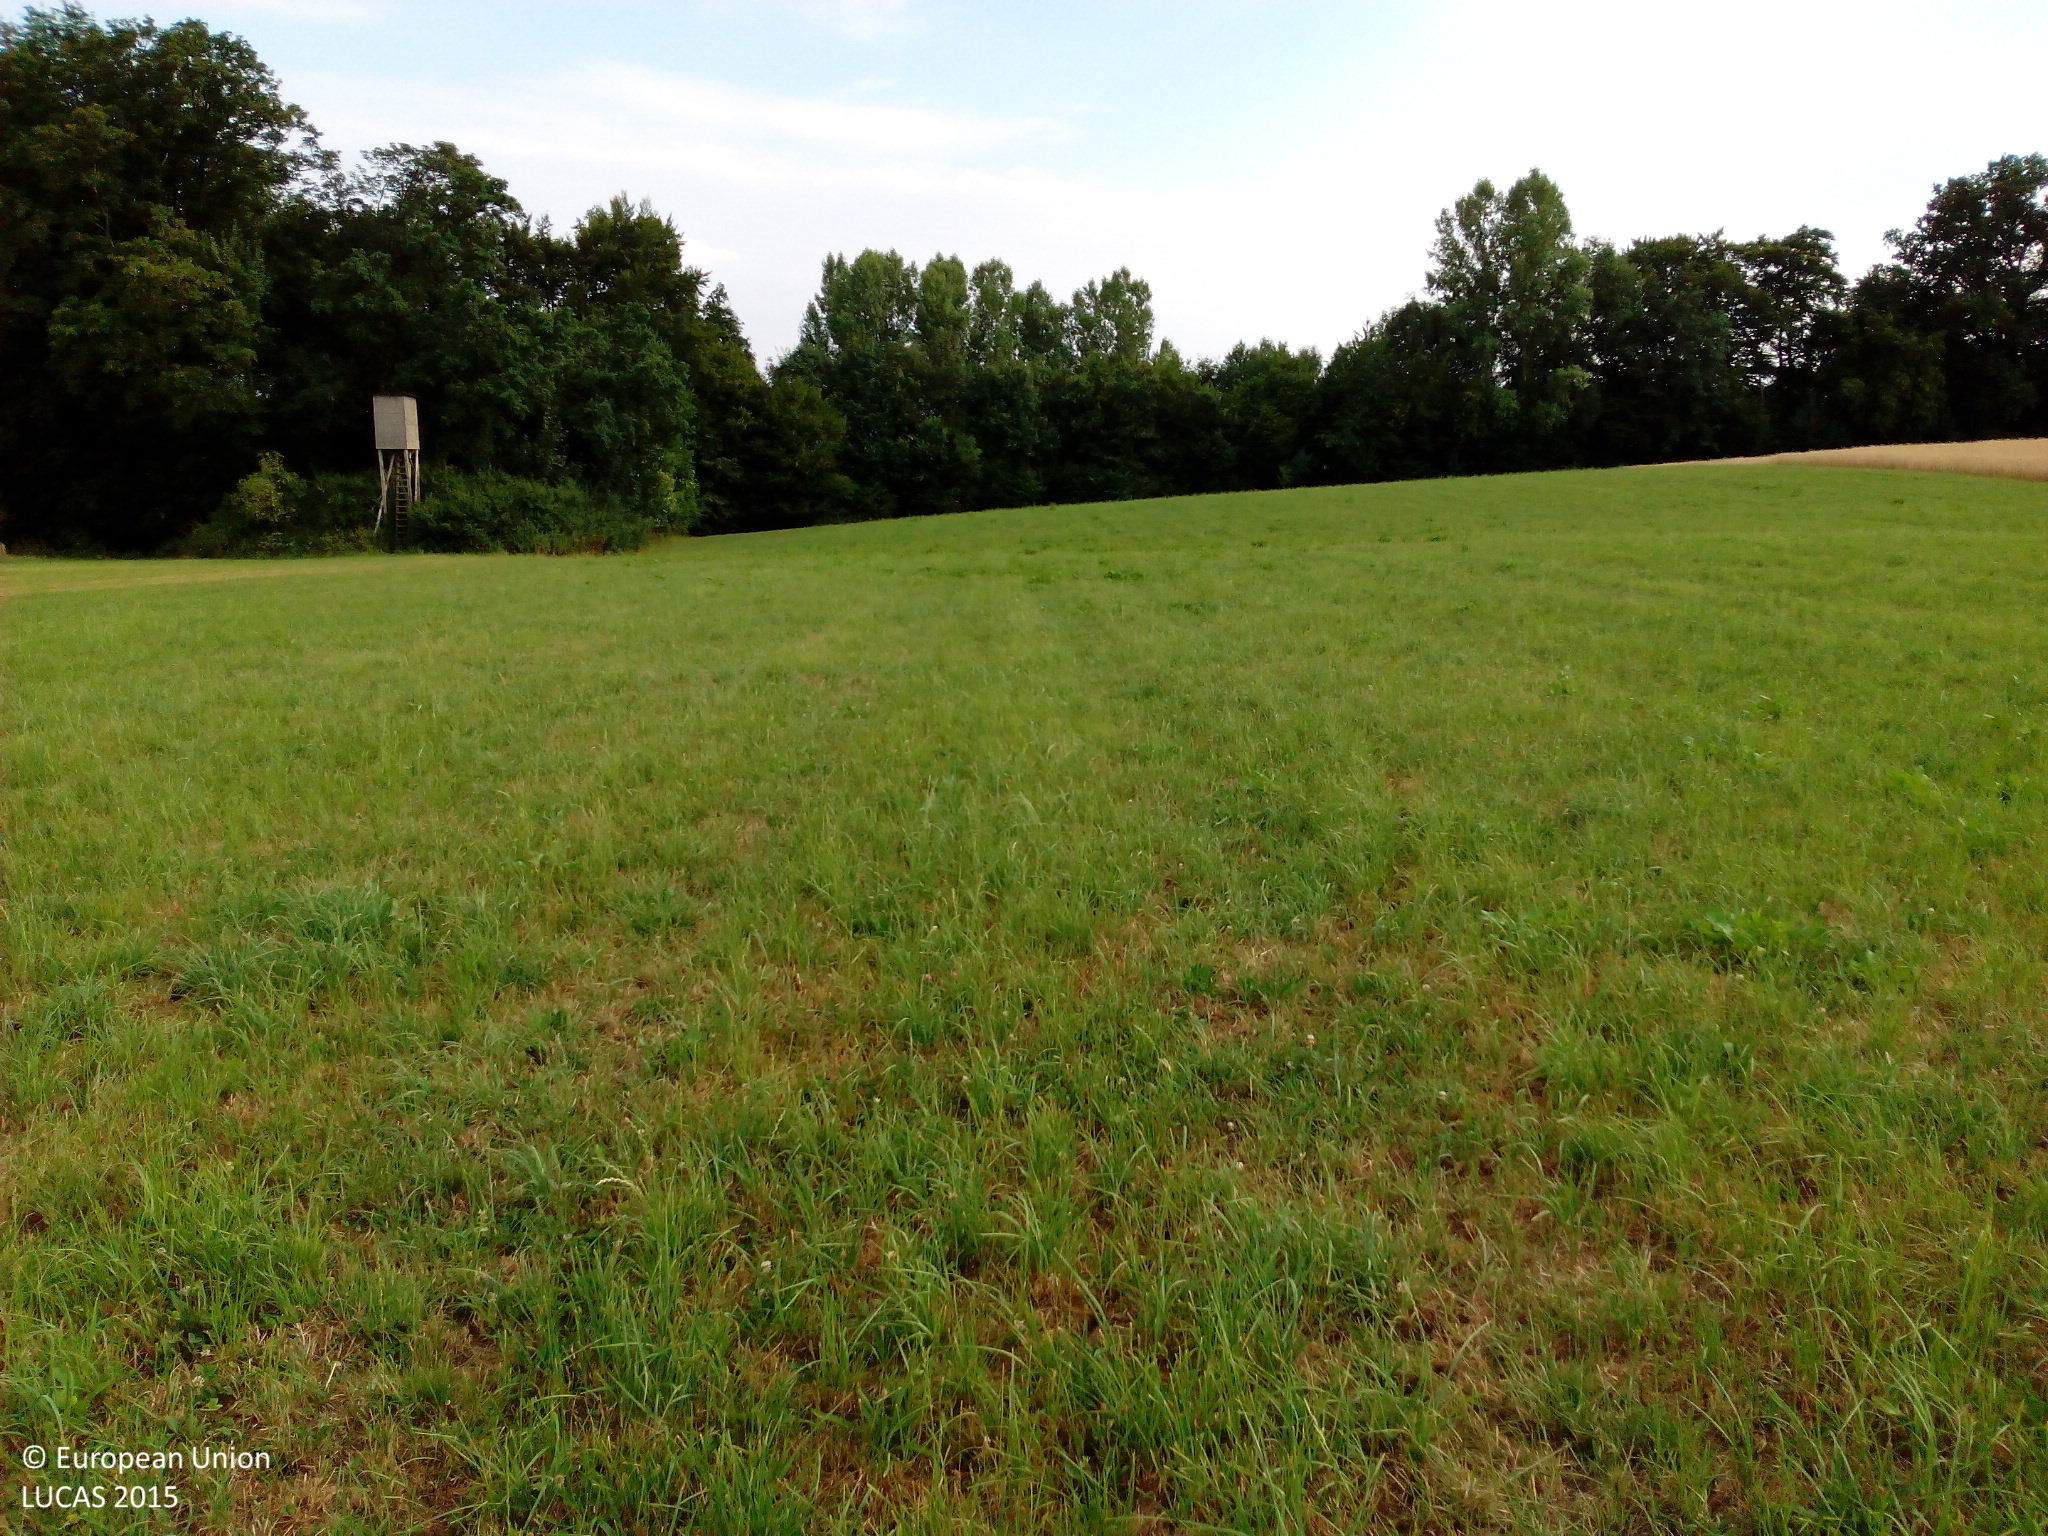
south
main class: Grassland
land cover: Grassland without tree/shrub cover
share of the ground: > 75 %
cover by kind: herbaceous plants 80 %, unconsolidated bare surface 20 %
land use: Agriculture (excluding fallow land and kitchen gardens)
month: July
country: DE
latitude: 48.8713
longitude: 9.9591
